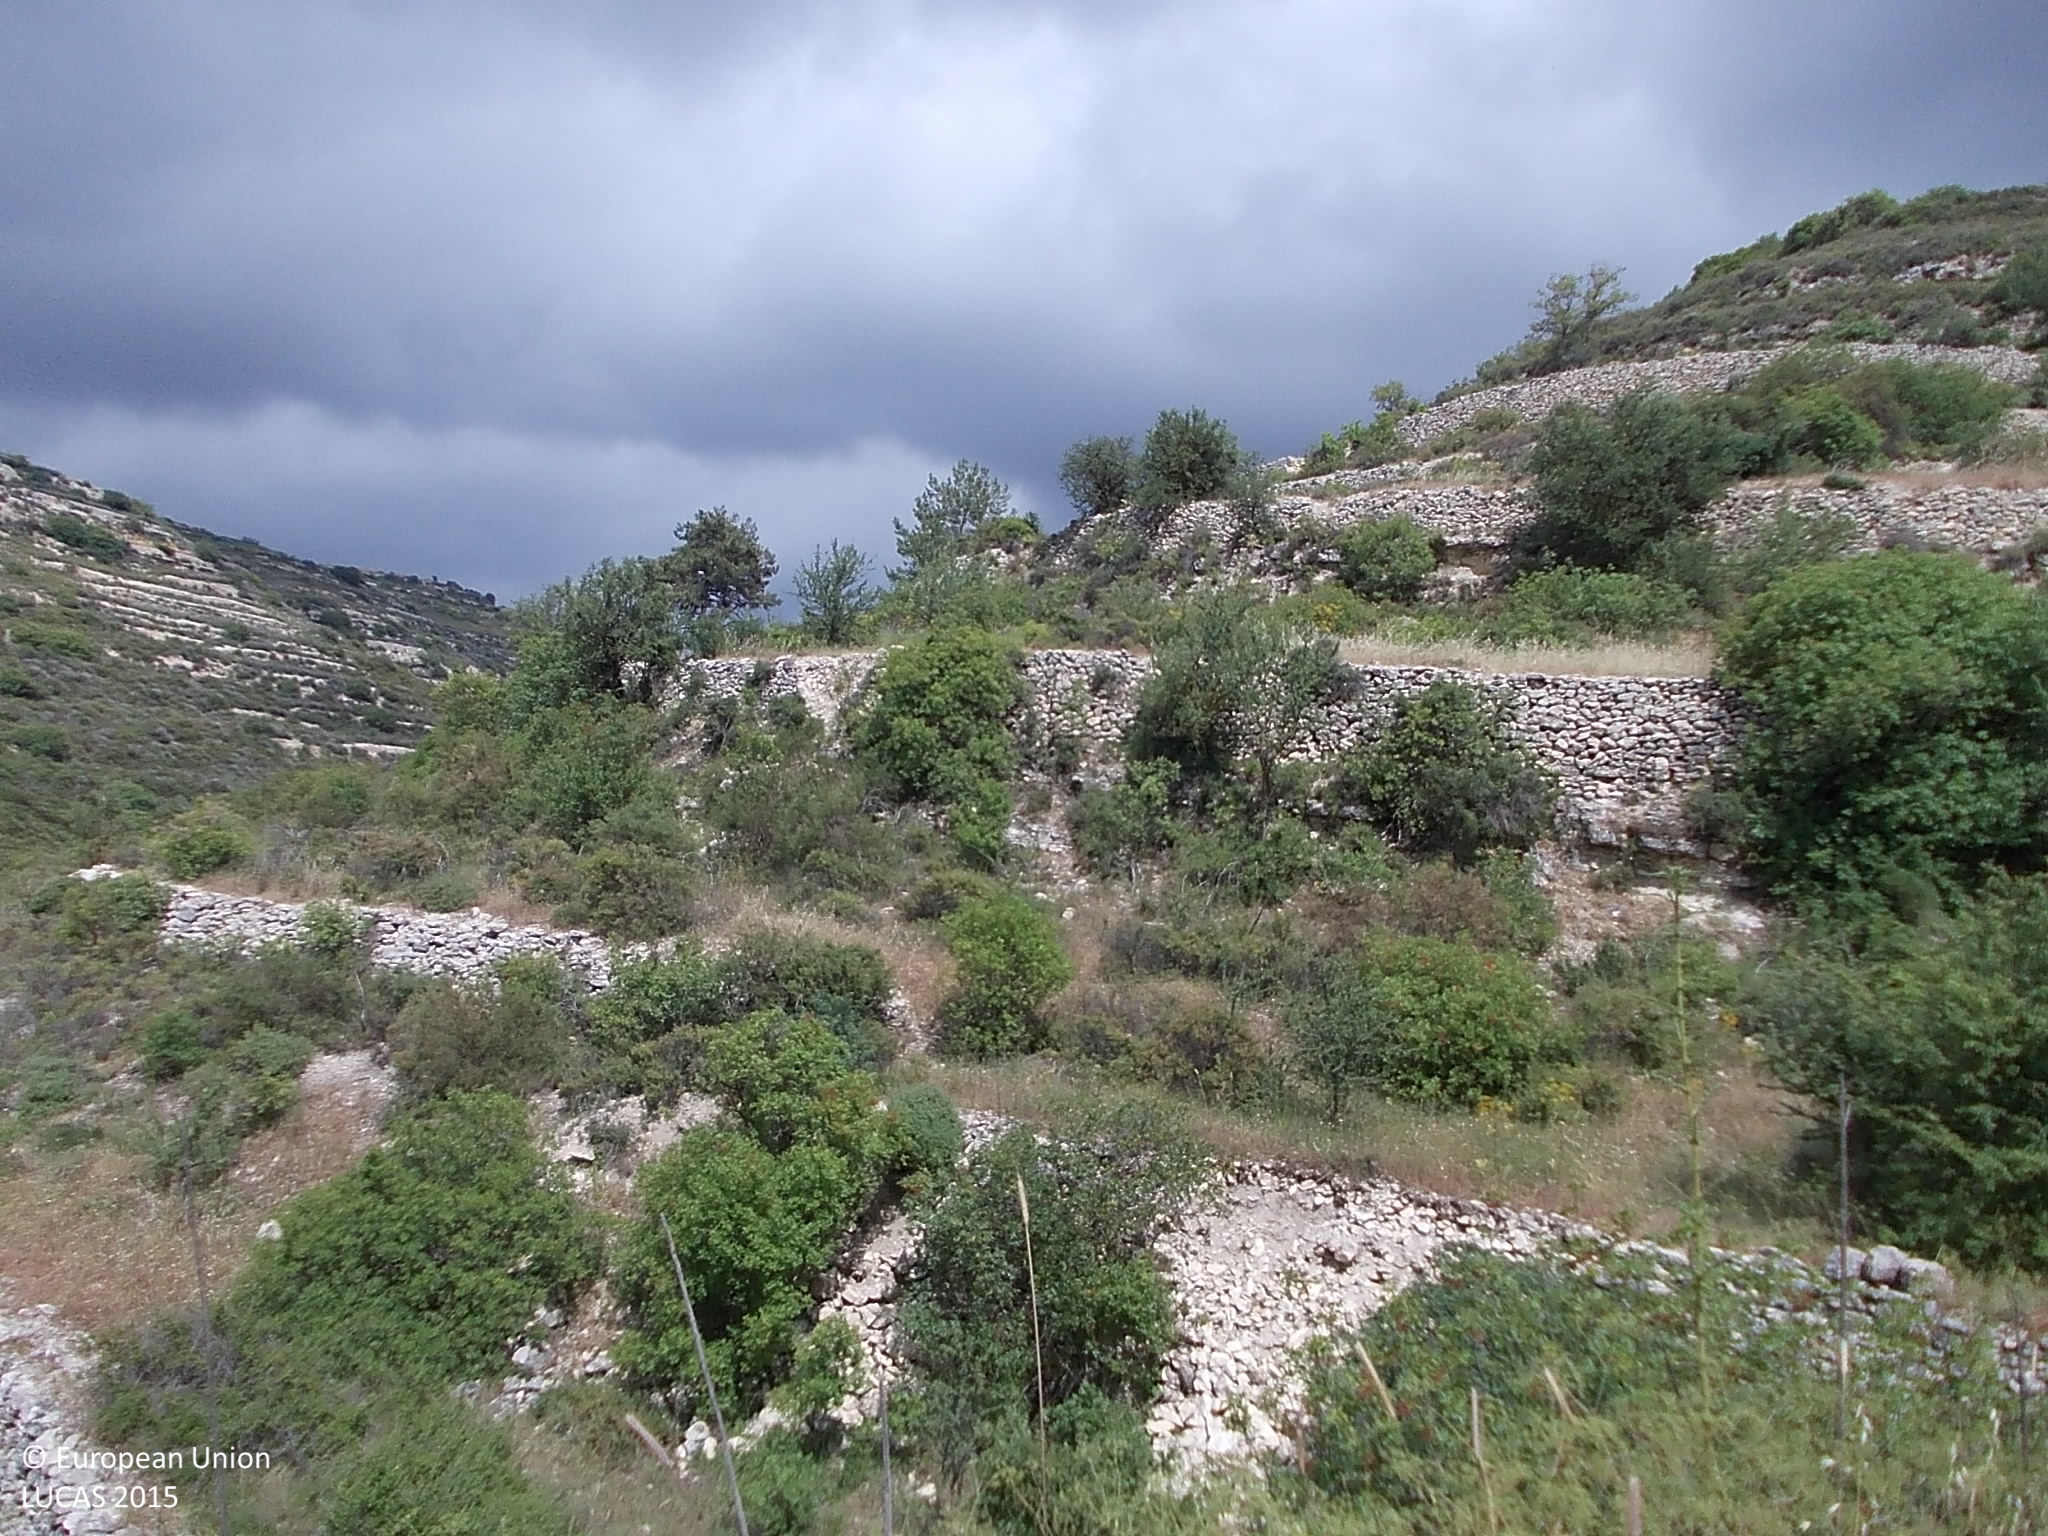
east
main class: Grassland
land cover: Grassland with sparse tree/shrub cover
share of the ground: > 75 %
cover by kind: herbaceous plants 85 %, broadleaved forest trees 5 %, shrubs 5 %, unconsolidated bare surface 5 %
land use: Abandoned areas
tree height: < 5 m
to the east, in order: Grassland with sparse tree/shrub cover; Dry stone walls; Shrubland with sparse tree cover; Dry stone walls; Shrubland with sparse tree cover; Dry stone walls; Shrubland with sparse tree cover; Dry stone walls; Grassland with sparse tree/shrub cover; Shrubland with sparse tree cover
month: May
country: CY
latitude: 34.8078
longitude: 32.7983
